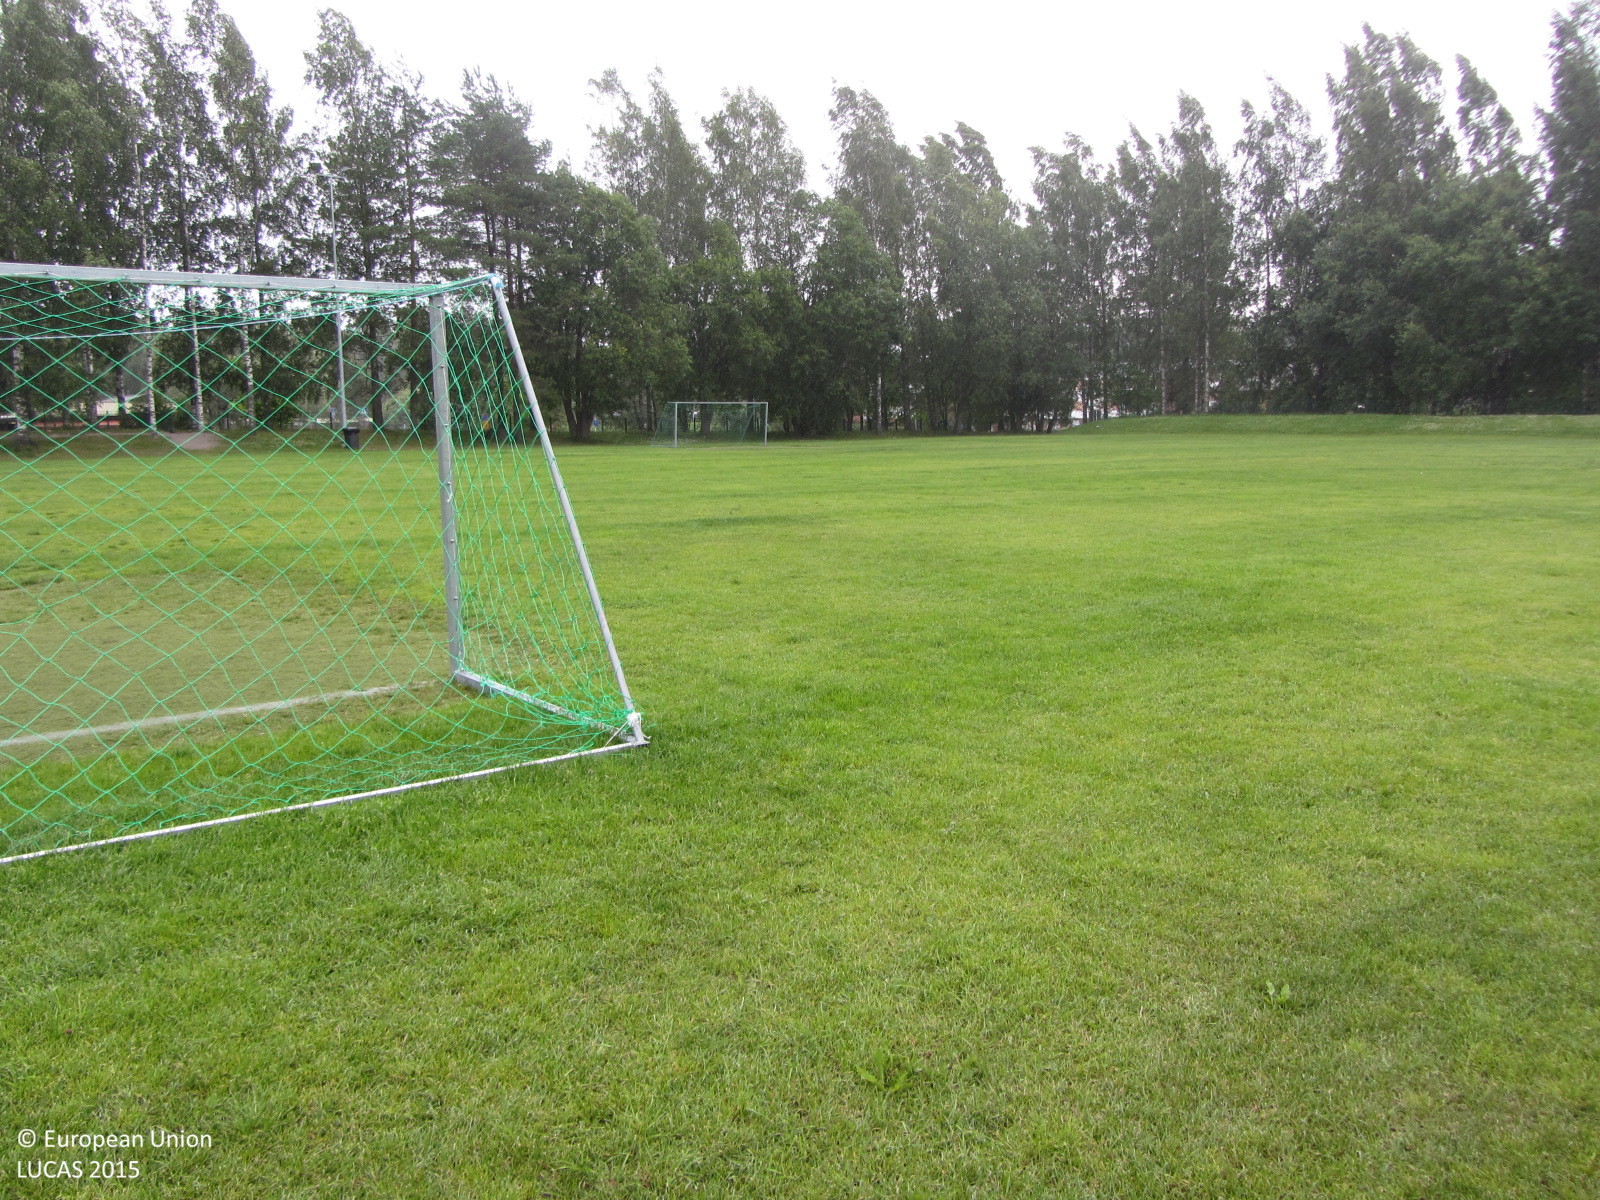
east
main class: Grassland
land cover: Grassland without tree/shrub cover
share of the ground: > 75 %
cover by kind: herbaceous plants 100 %
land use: Sport
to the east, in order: Grassland without tree/shrub cover; Broadleaved woodland; Artificial constructions in urban areas
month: July
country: FI
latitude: 60.6395
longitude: 24.8312
